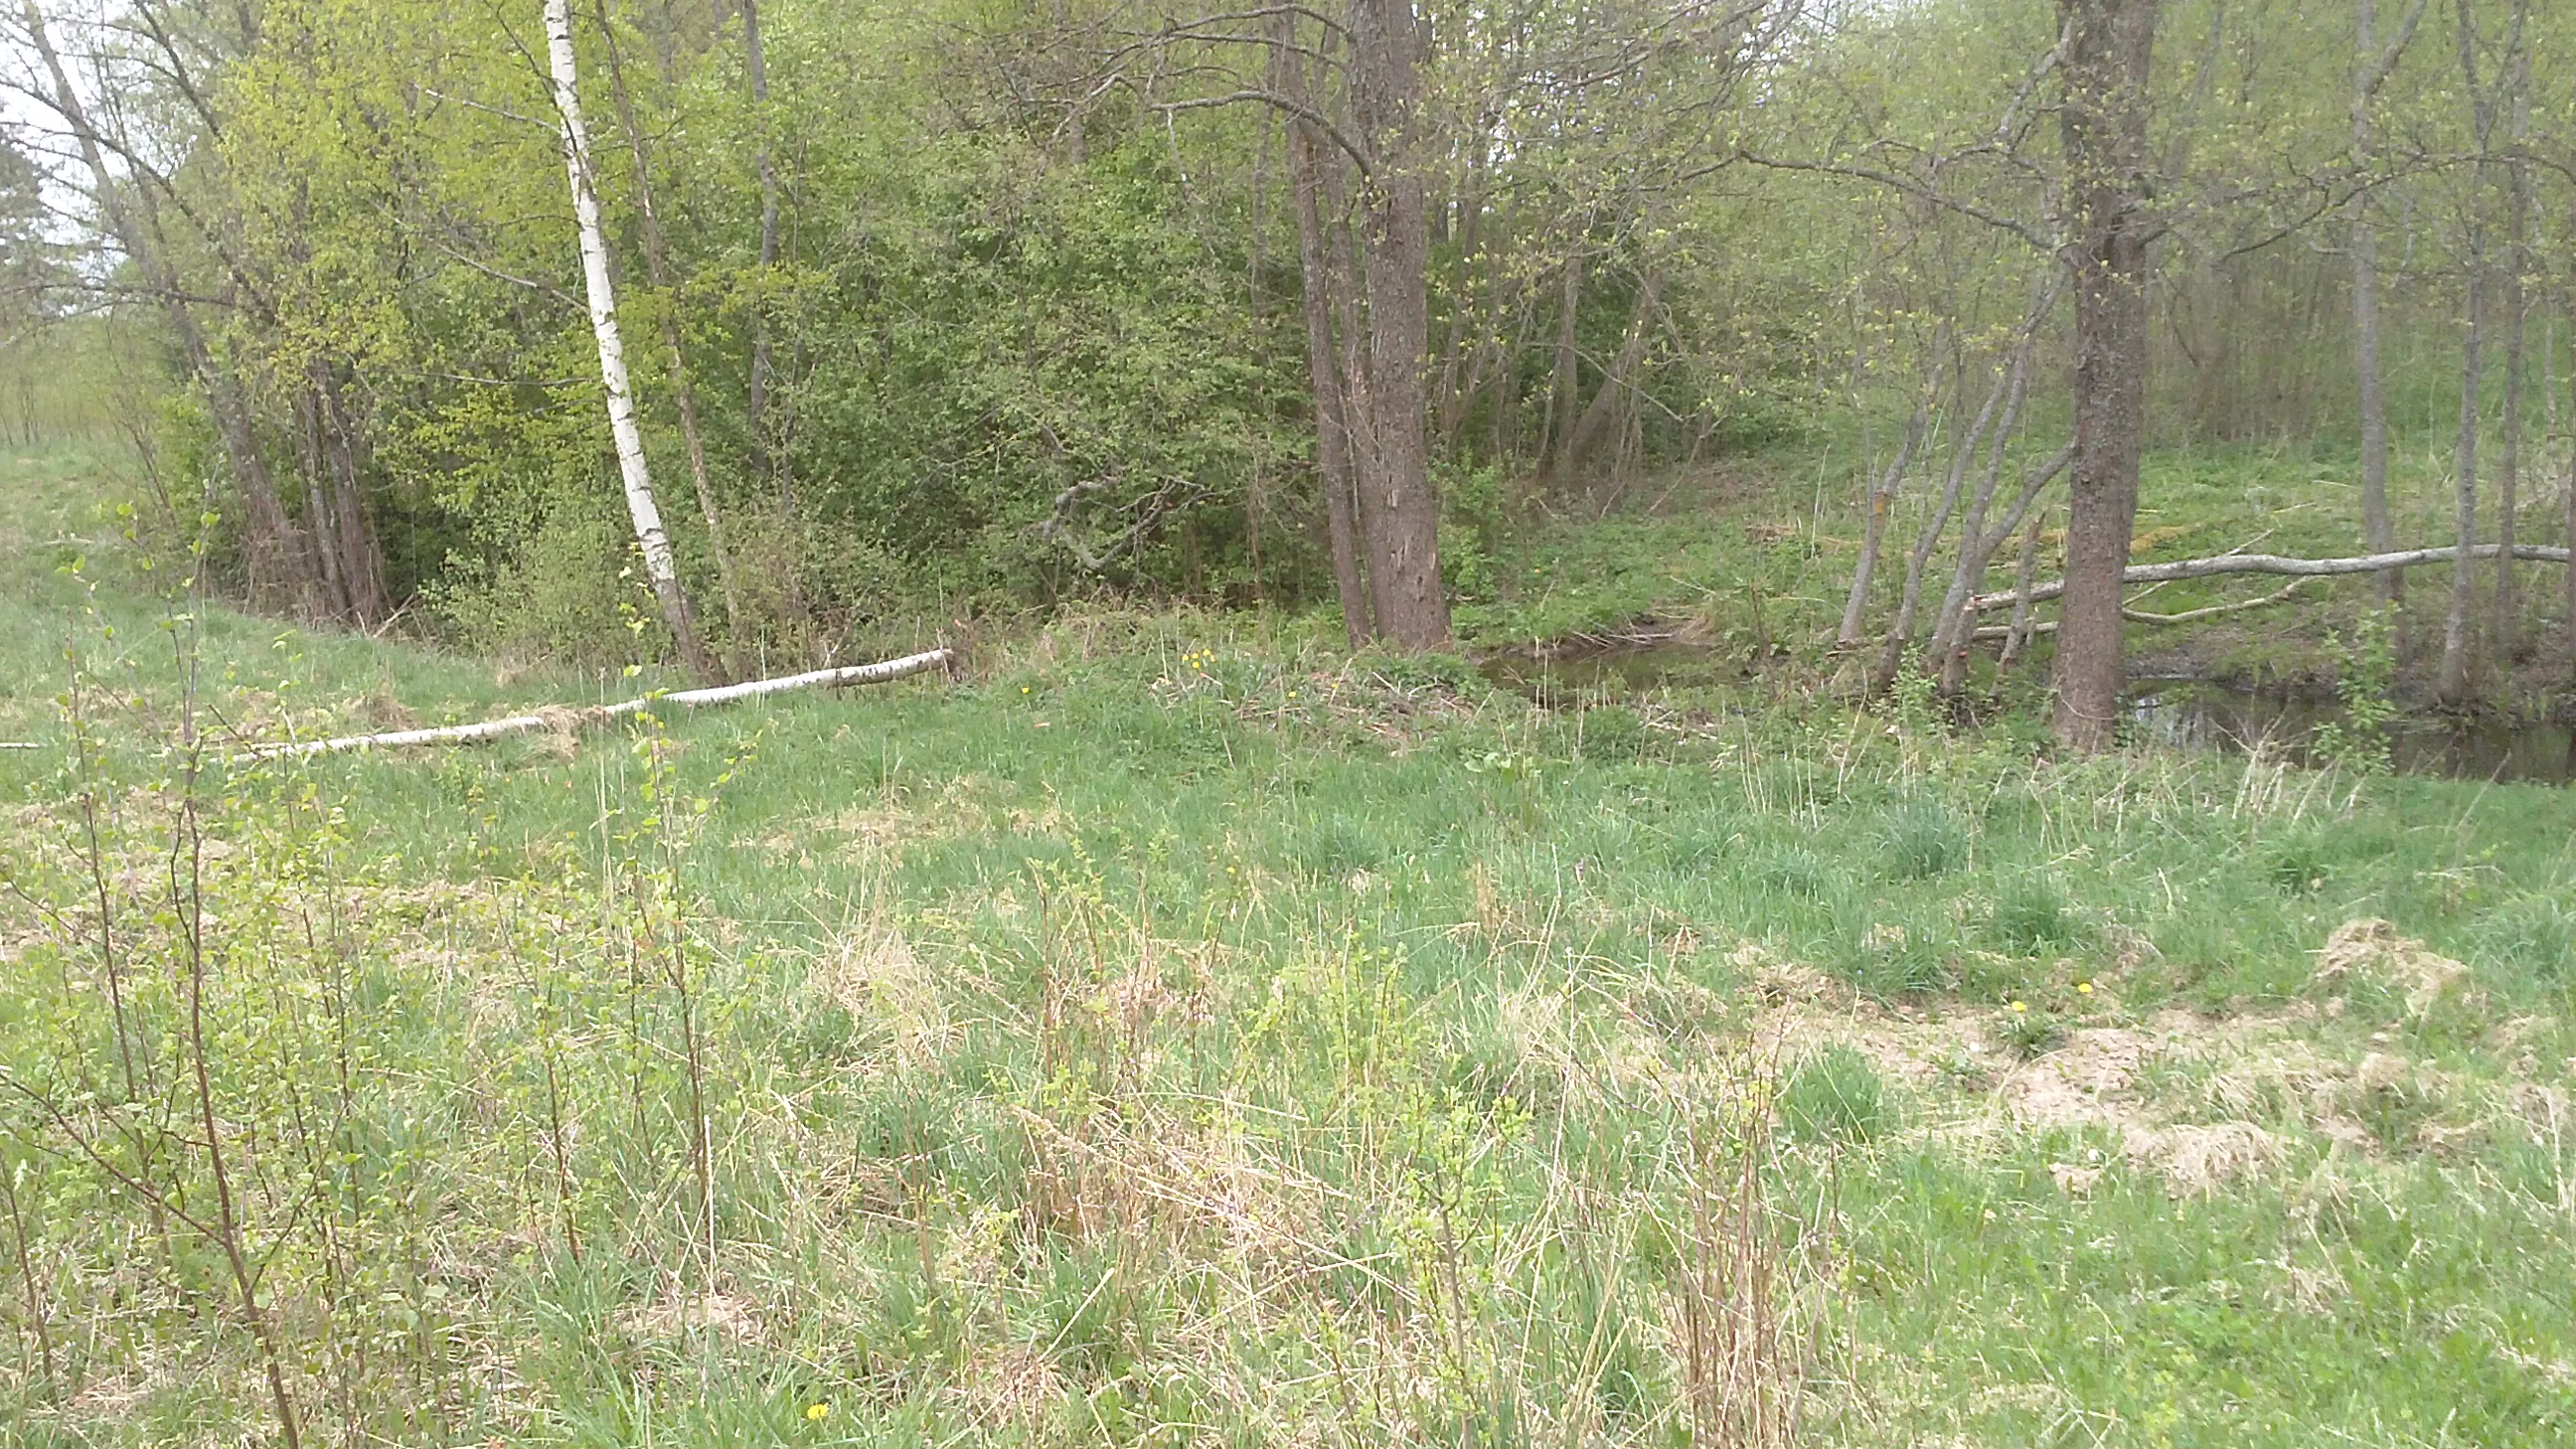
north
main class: Grassland
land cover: Grassland with sparse tree/shrub cover
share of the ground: > 75 %
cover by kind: herbaceous plants 90 %, broadleaved forest trees 5 %, shrubs 5 %
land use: Forestry
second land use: Agriculture (excluding fallow land and kitchen gardens)
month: May
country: LV
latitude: 56.0270
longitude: 27.0637
